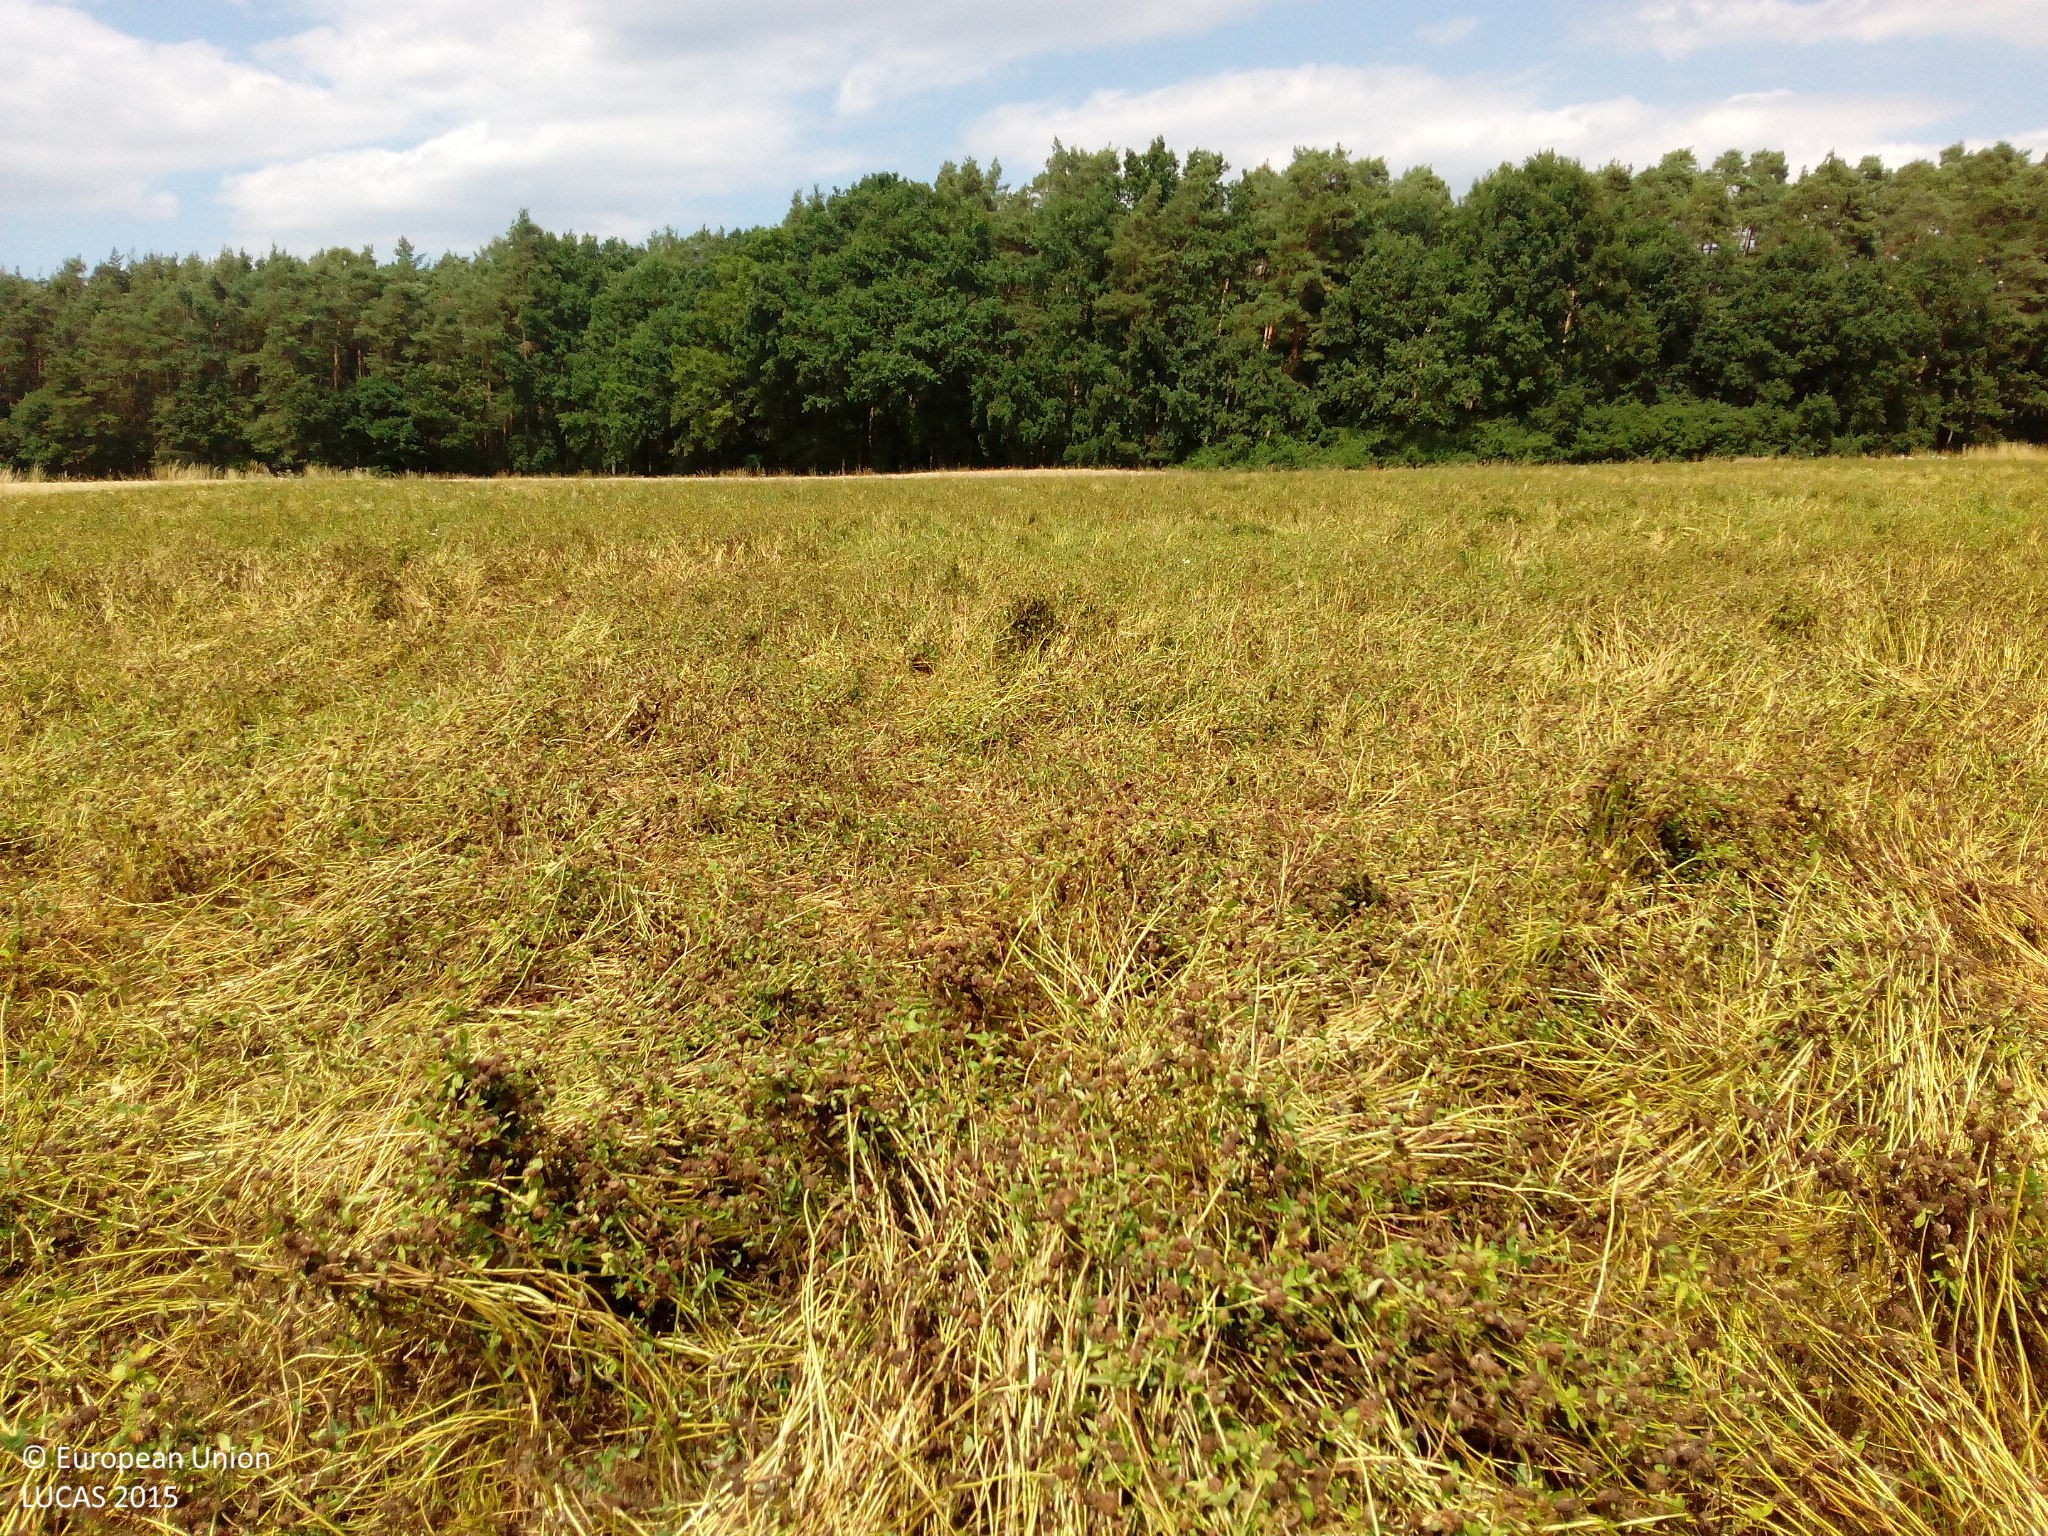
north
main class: Cropland
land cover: Clovers
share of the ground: > 75 %
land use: Agriculture (excluding fallow land and kitchen gardens)
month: July
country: DE
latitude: 49.5690
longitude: 10.9261
